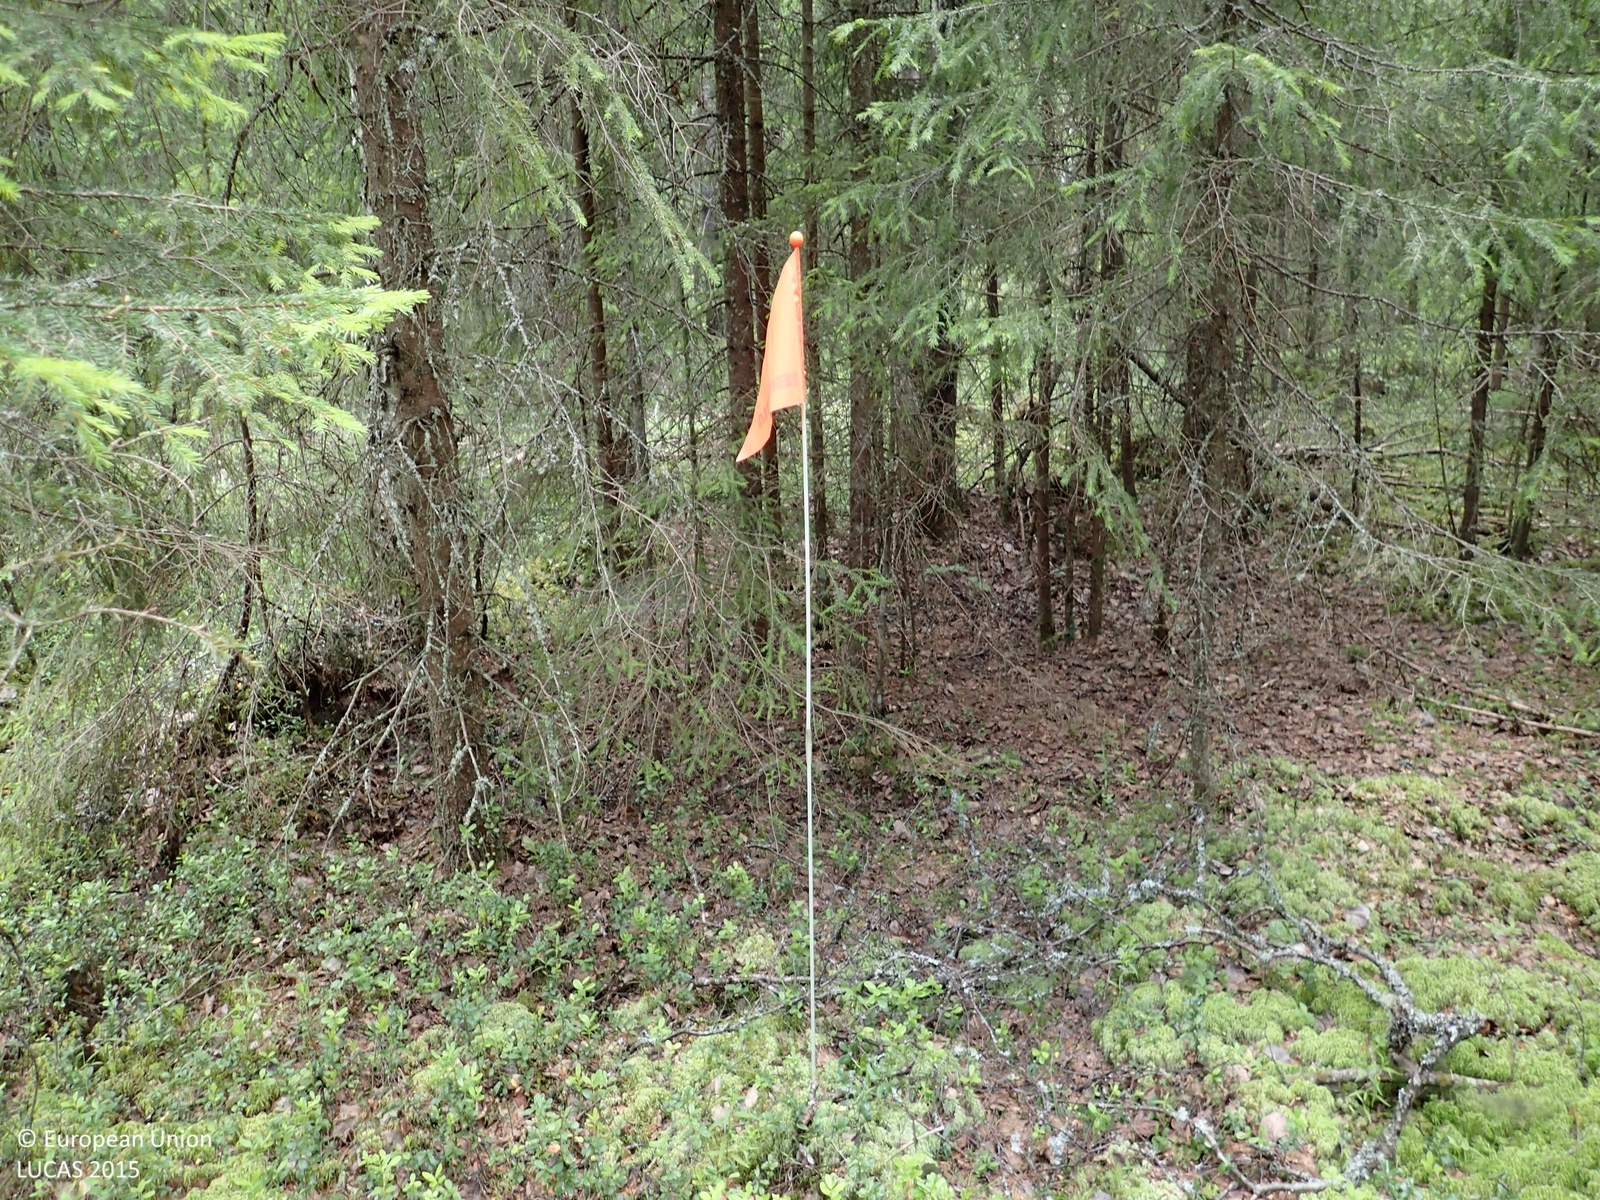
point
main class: Woodland
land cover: Spruce dominated coniferous woodland
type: boreal forest
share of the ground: > 75 %
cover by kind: coniferous forest trees 80 %, shrubs 10 %, broadleaved forest trees 5 %, lichens and mosses 5 %
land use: Forestry
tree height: > 5 m
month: July
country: FI
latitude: 62.7518
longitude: 21.7715
